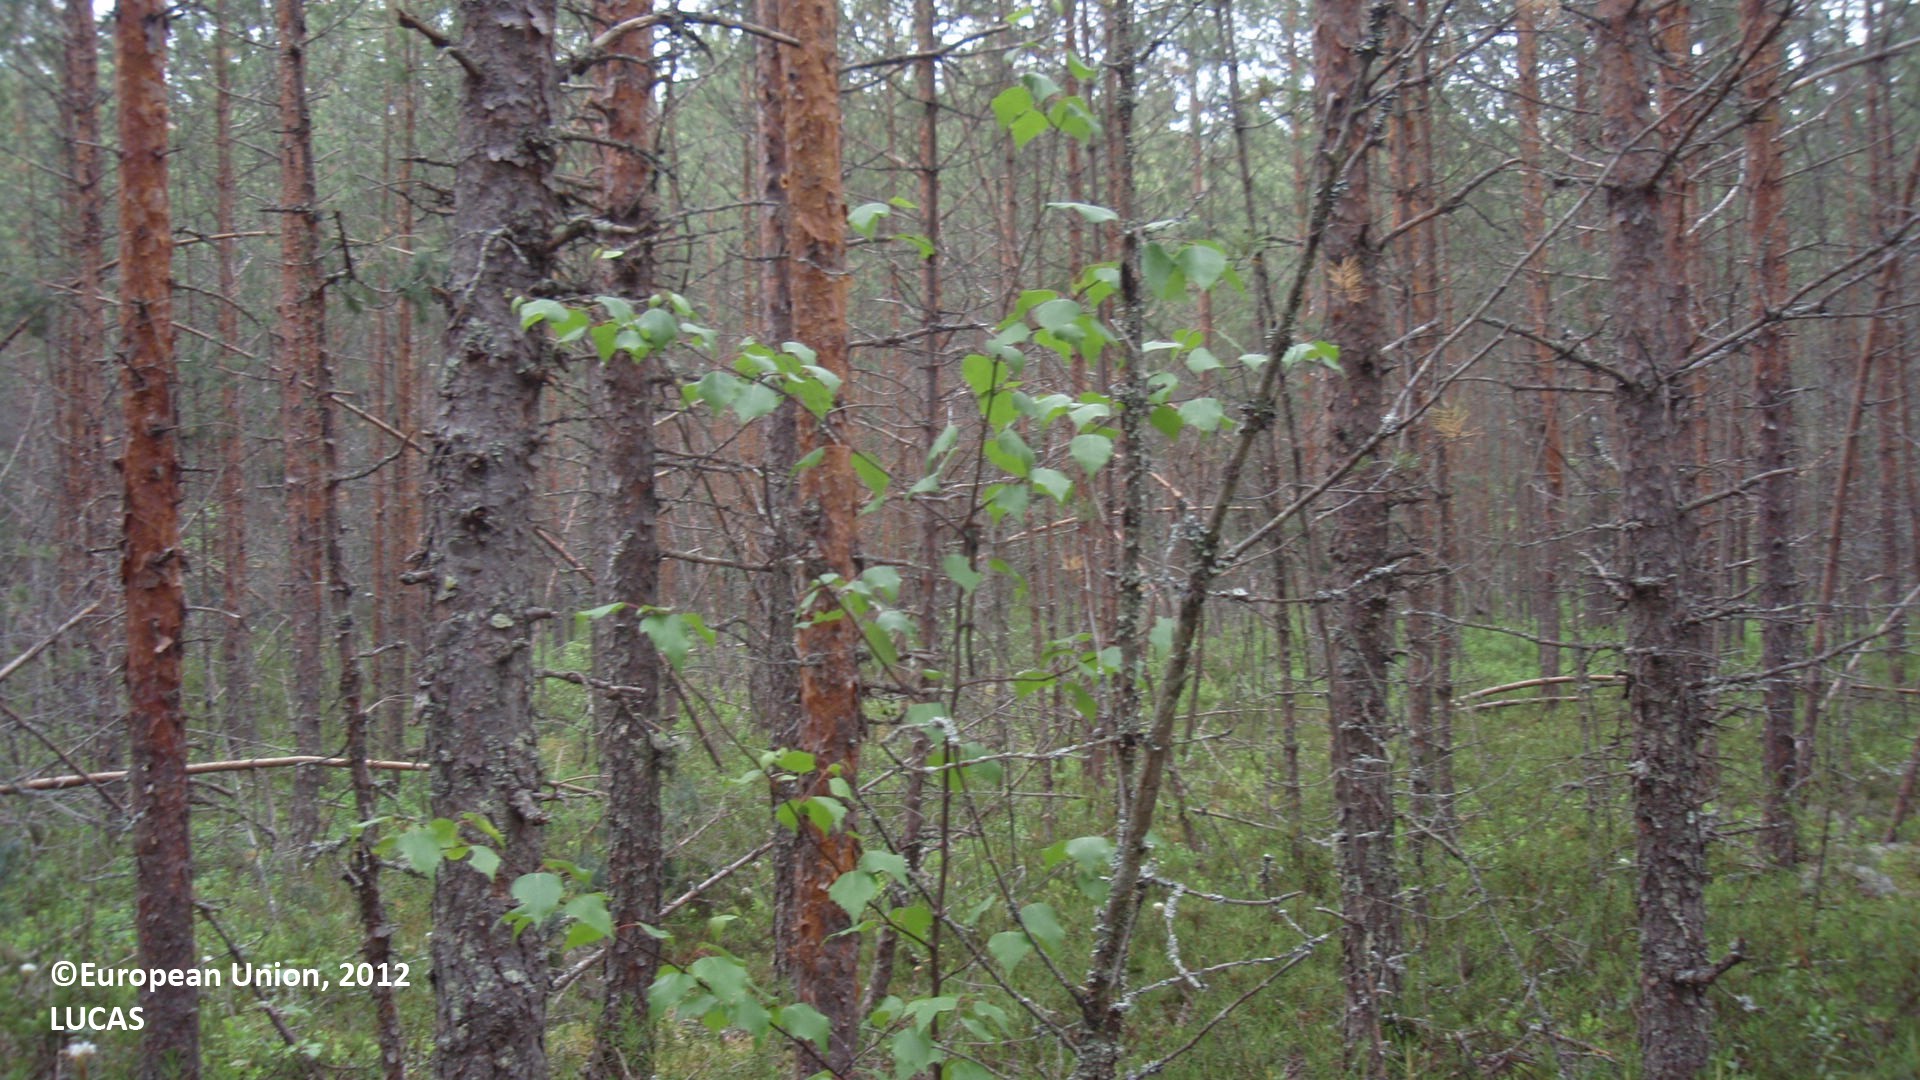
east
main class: Woodland
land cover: Pine dominated coniferous woodland
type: boreal forest
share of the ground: > 75 %
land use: Forestry
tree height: > 5 m
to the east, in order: Pine dominated coniferous woodland; Ditches and canals; Pine dominated coniferous woodland; Ditches and canals; Pine dominated coniferous woodland; Paved roads, cycling and walking lanes; Pine dominated coniferous woodland; Broadleaved woodland; Inland water bodies; Artificial constructions in urban areas; Broadleaved woodland
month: June
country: FI
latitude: 61.0891
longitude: 26.7542
